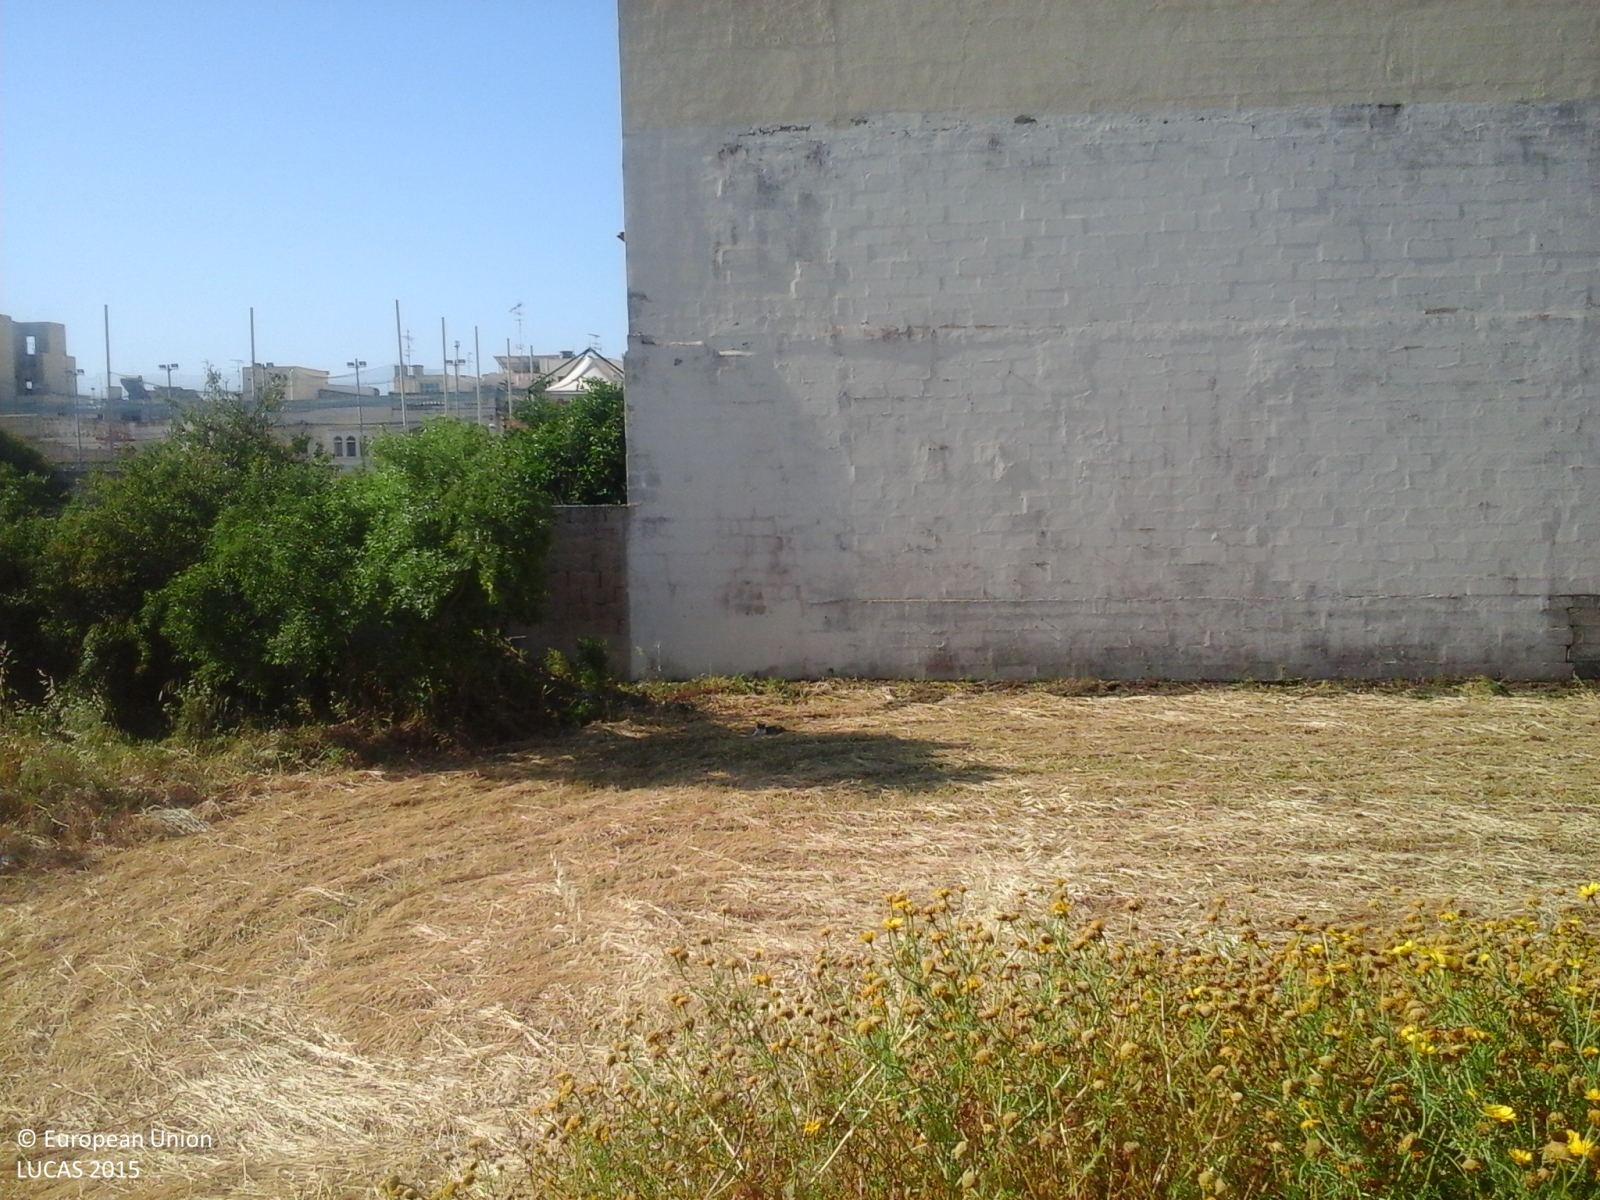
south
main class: Cropland
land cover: Mixed cereals for fodder
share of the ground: > 75 %
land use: Agriculture (excluding fallow land and kitchen gardens)
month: May
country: MT
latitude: 35.8582
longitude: 14.4875
